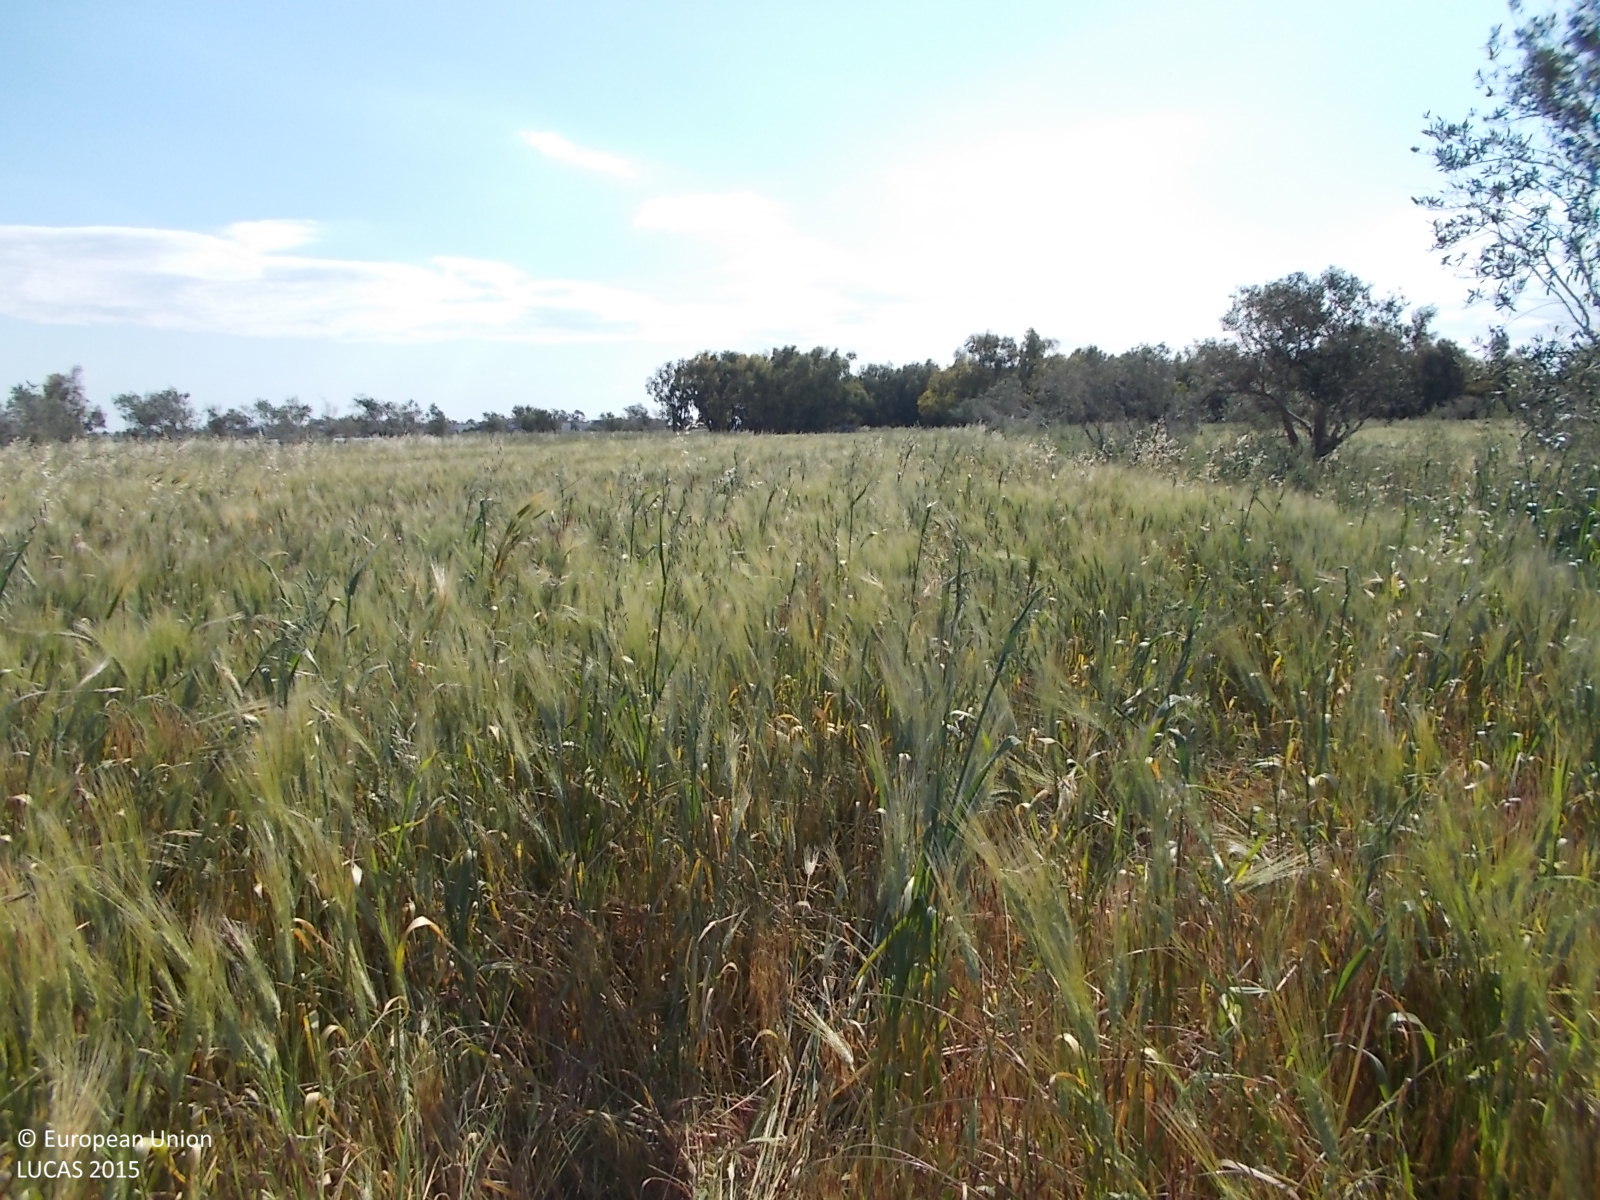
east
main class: Cropland
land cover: Mixed cereals for fodder
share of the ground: > 75 %
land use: Agriculture (excluding fallow land and kitchen gardens)
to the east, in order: Mixed cereals for fodder; Grass margins; Tracks; Other bare soil; Broadleaved woodland; Tracks; Common wheat; Other bare soil
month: April
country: CY
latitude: 34.8431
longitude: 33.6068
